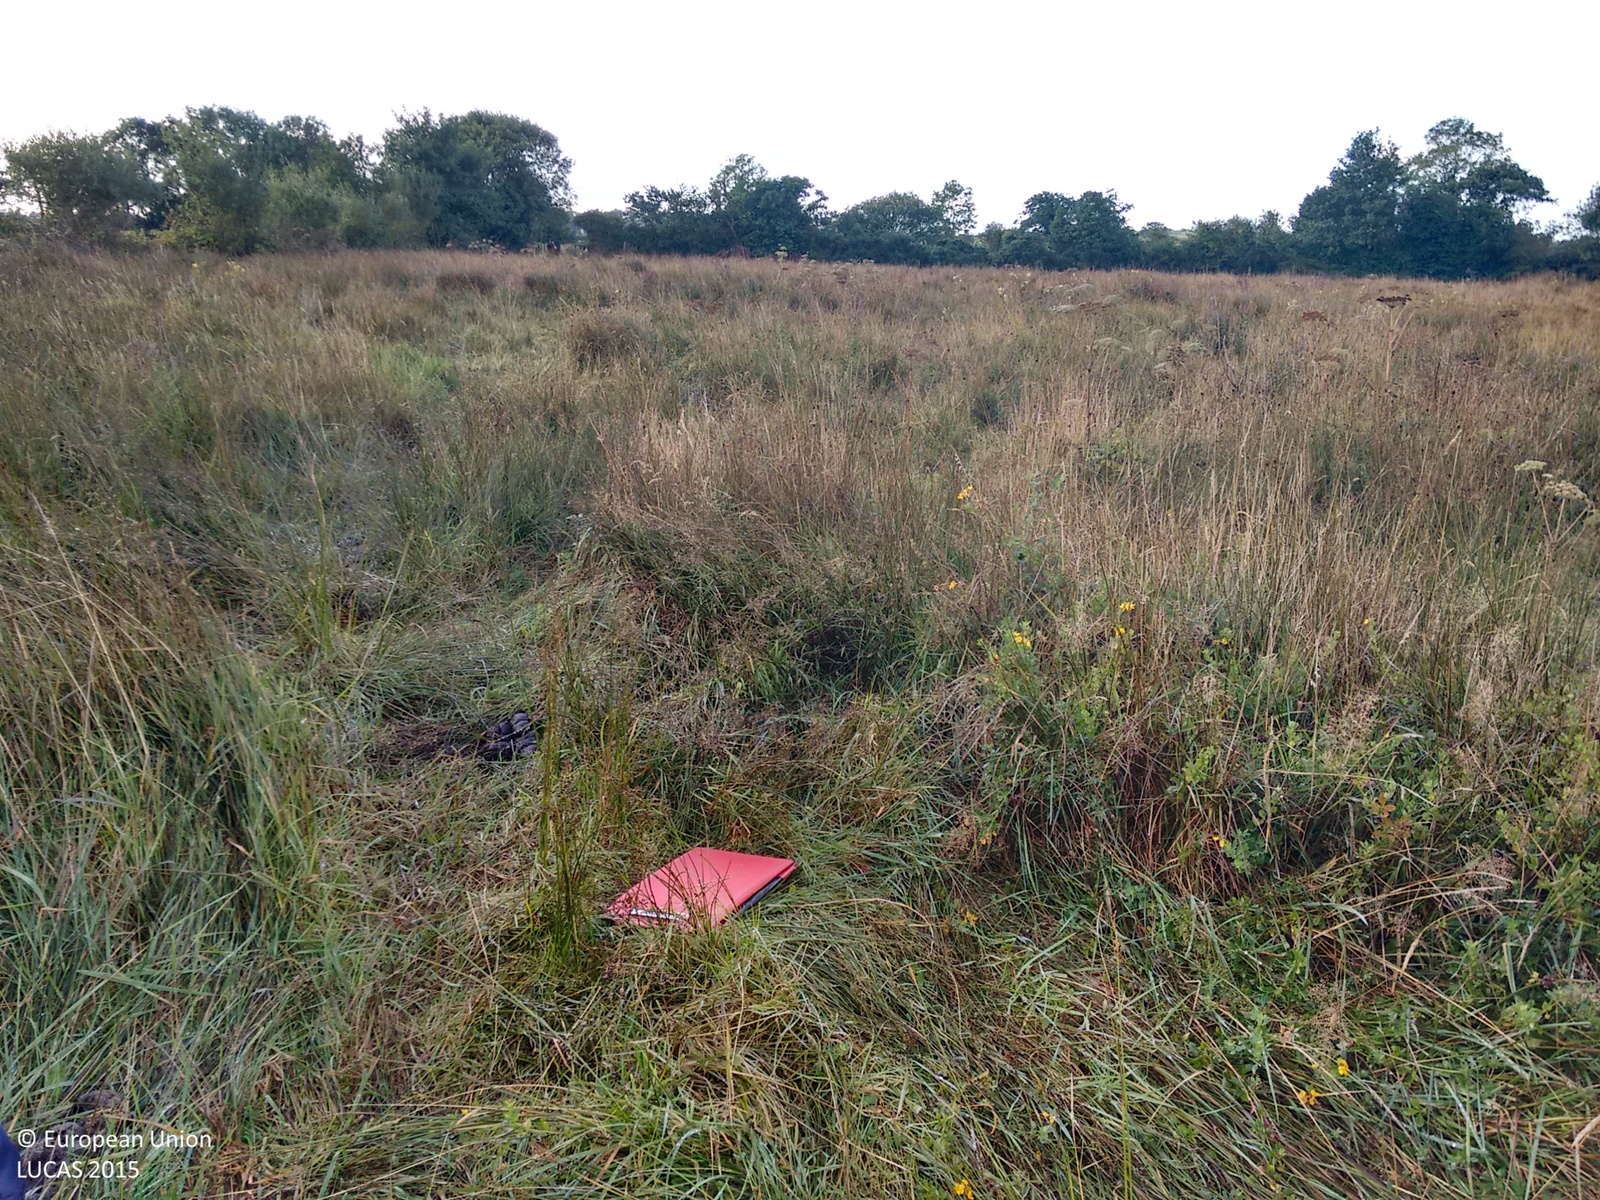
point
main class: Grassland
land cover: Spontaneously vegetated surfaces
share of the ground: > 75 %
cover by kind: herbaceous plants 100 %
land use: Agriculture (excluding fallow land and kitchen gardens)
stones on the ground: < 10 %
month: September
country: IE
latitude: 55.0254
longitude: -7.6315
